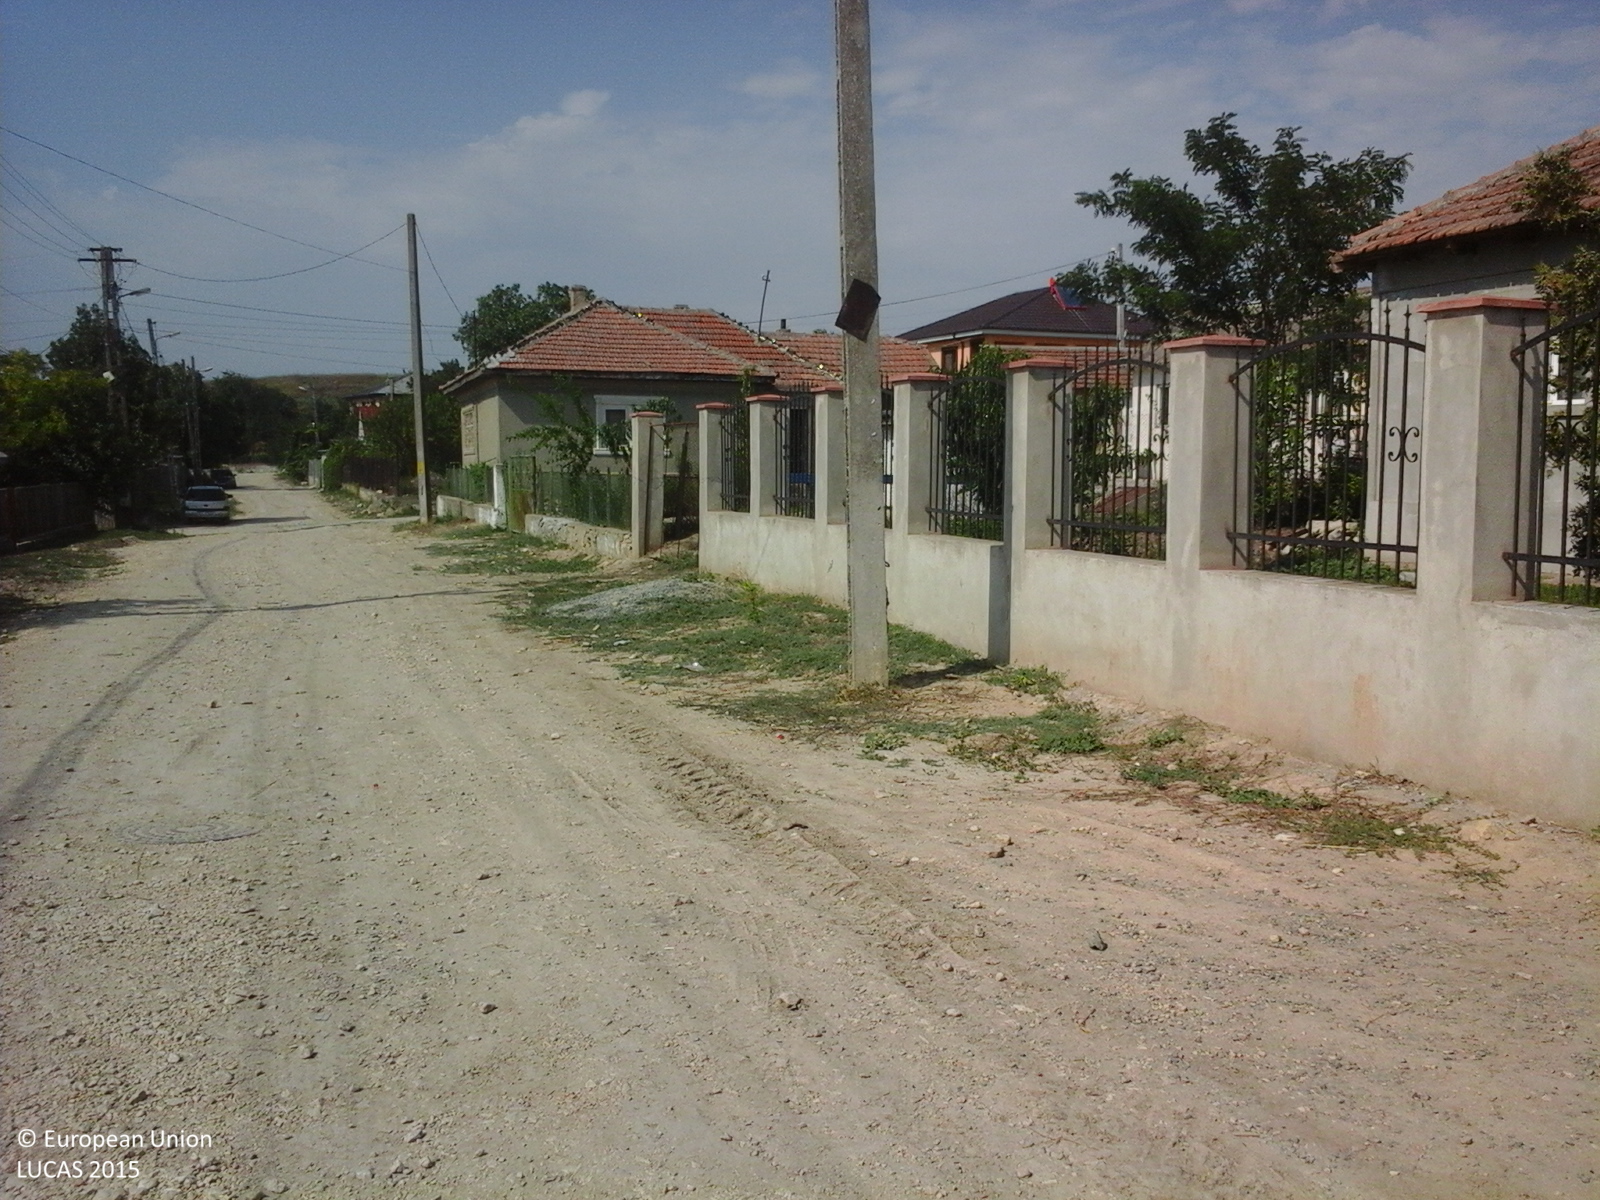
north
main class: Cropland
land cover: Other fruit trees and berries
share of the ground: 50 - 75 %
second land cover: Grassland without tree/shrub cover
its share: > 75 %
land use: Agriculture (excluding fallow land and kitchen gardens)
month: August
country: RO
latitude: 44.2018
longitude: 28.3988
